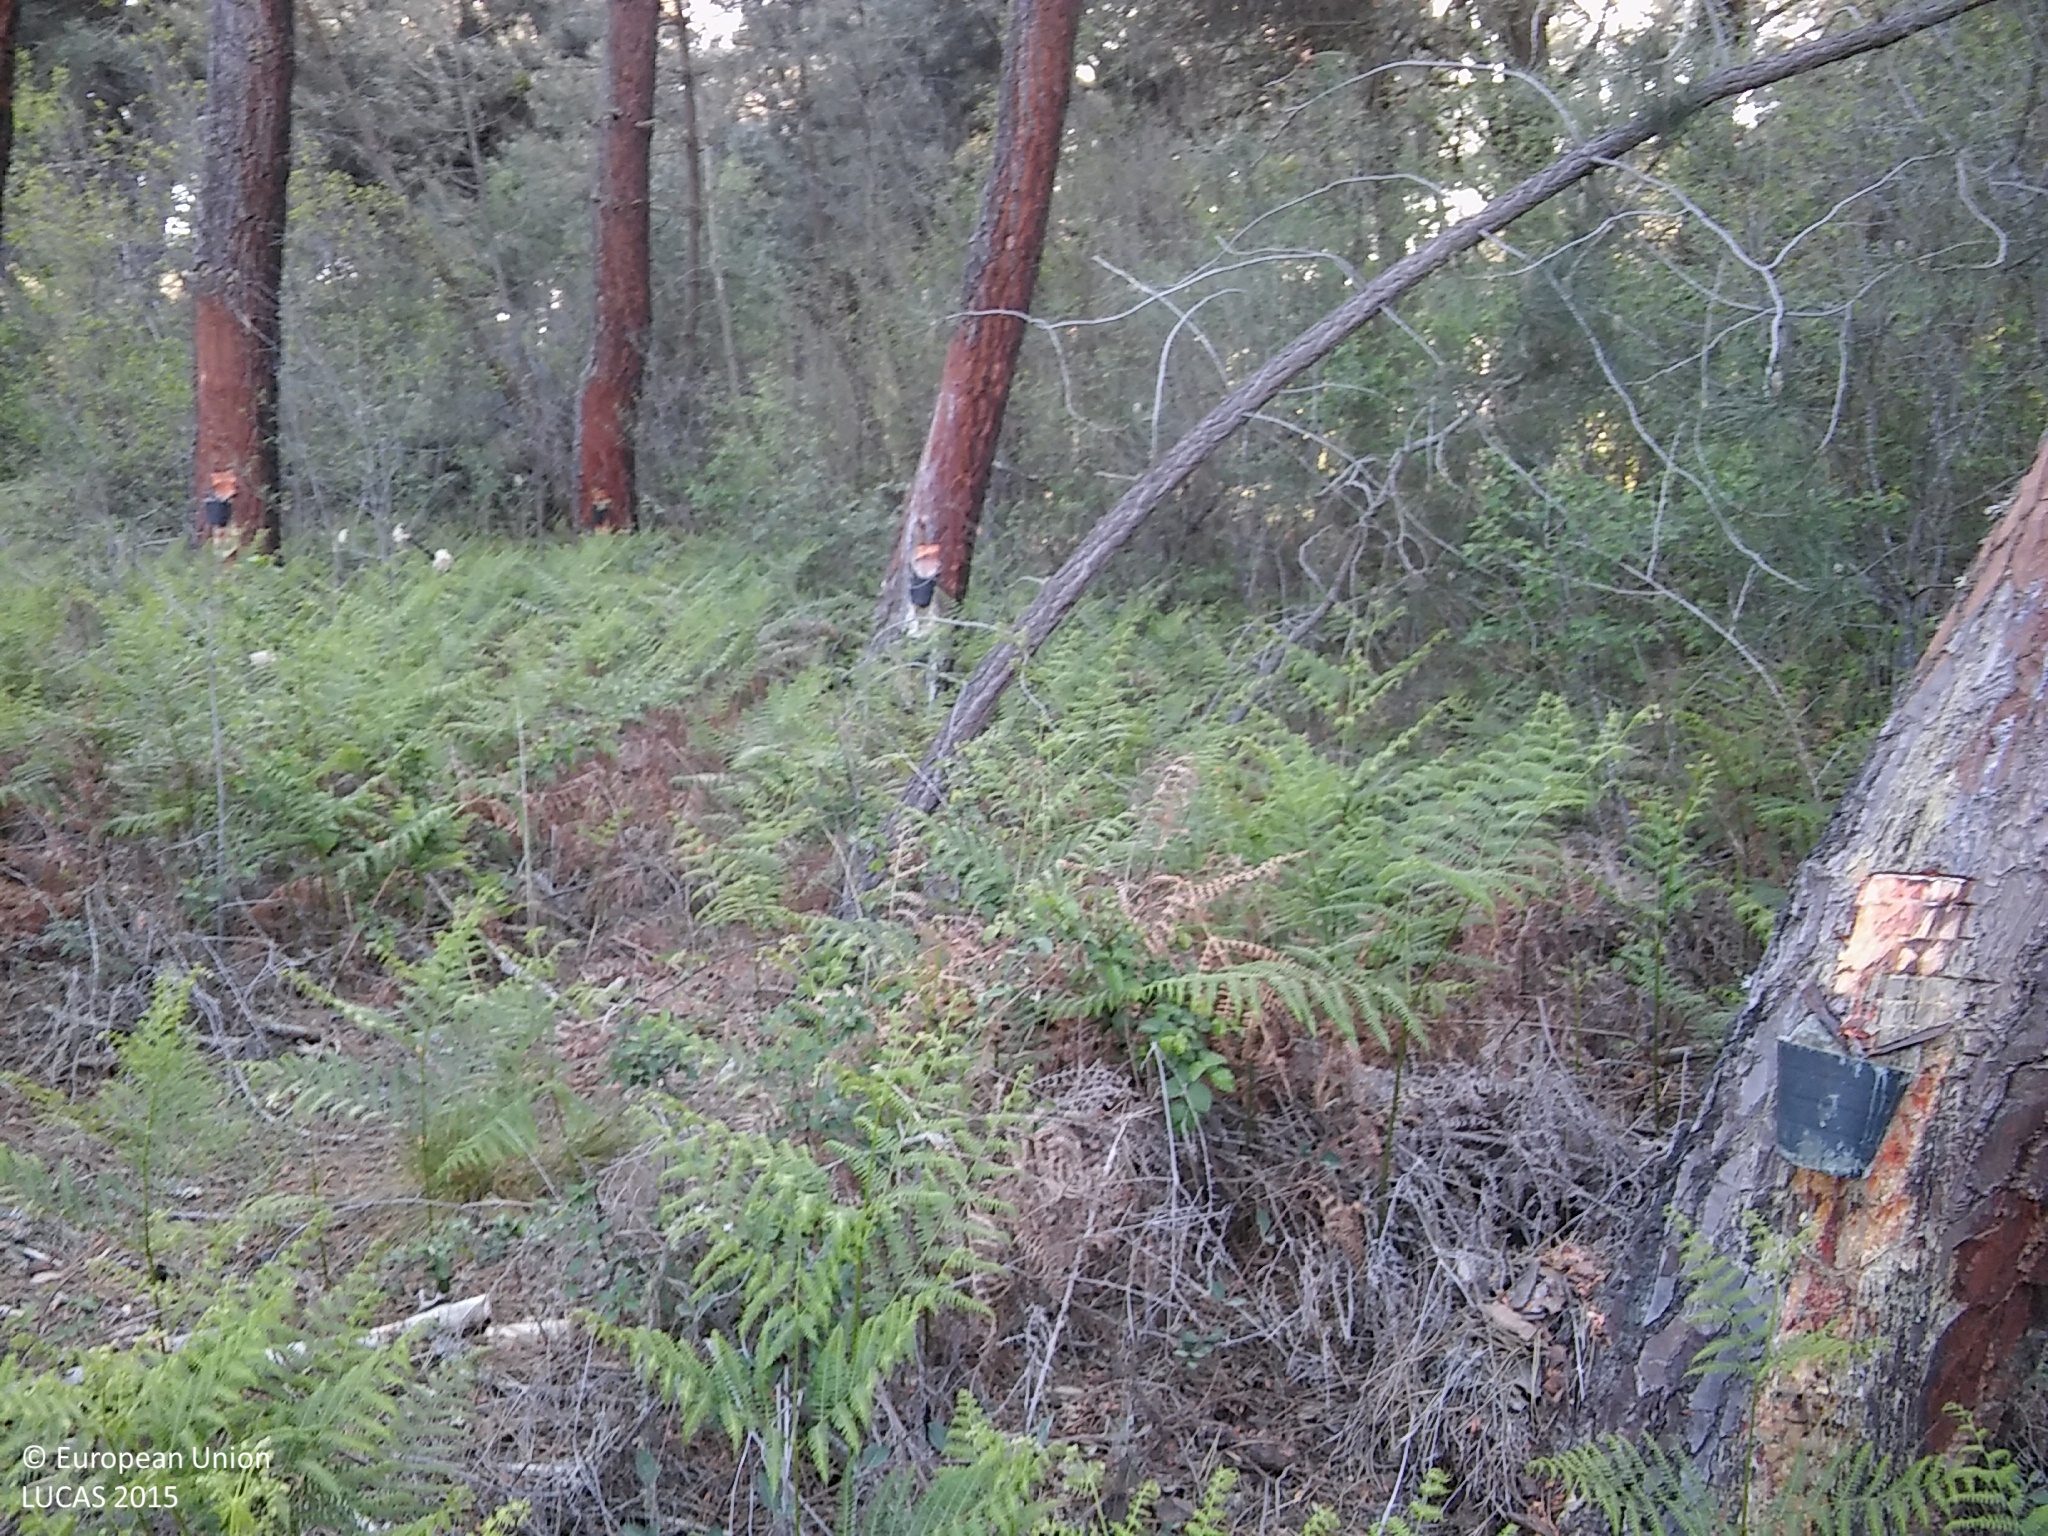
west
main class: Woodland
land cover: Pine dominated mixed woodland
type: coniferous forest of the mediterranean region
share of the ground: 50 - 75 %
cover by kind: coniferous forest trees 55 %, broadleaved forest trees 20 %, shrubs 20 %, herbaceous plants 5 %
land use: Forestry
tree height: > 5 m
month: May
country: ES
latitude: 41.3466
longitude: -4.0007
